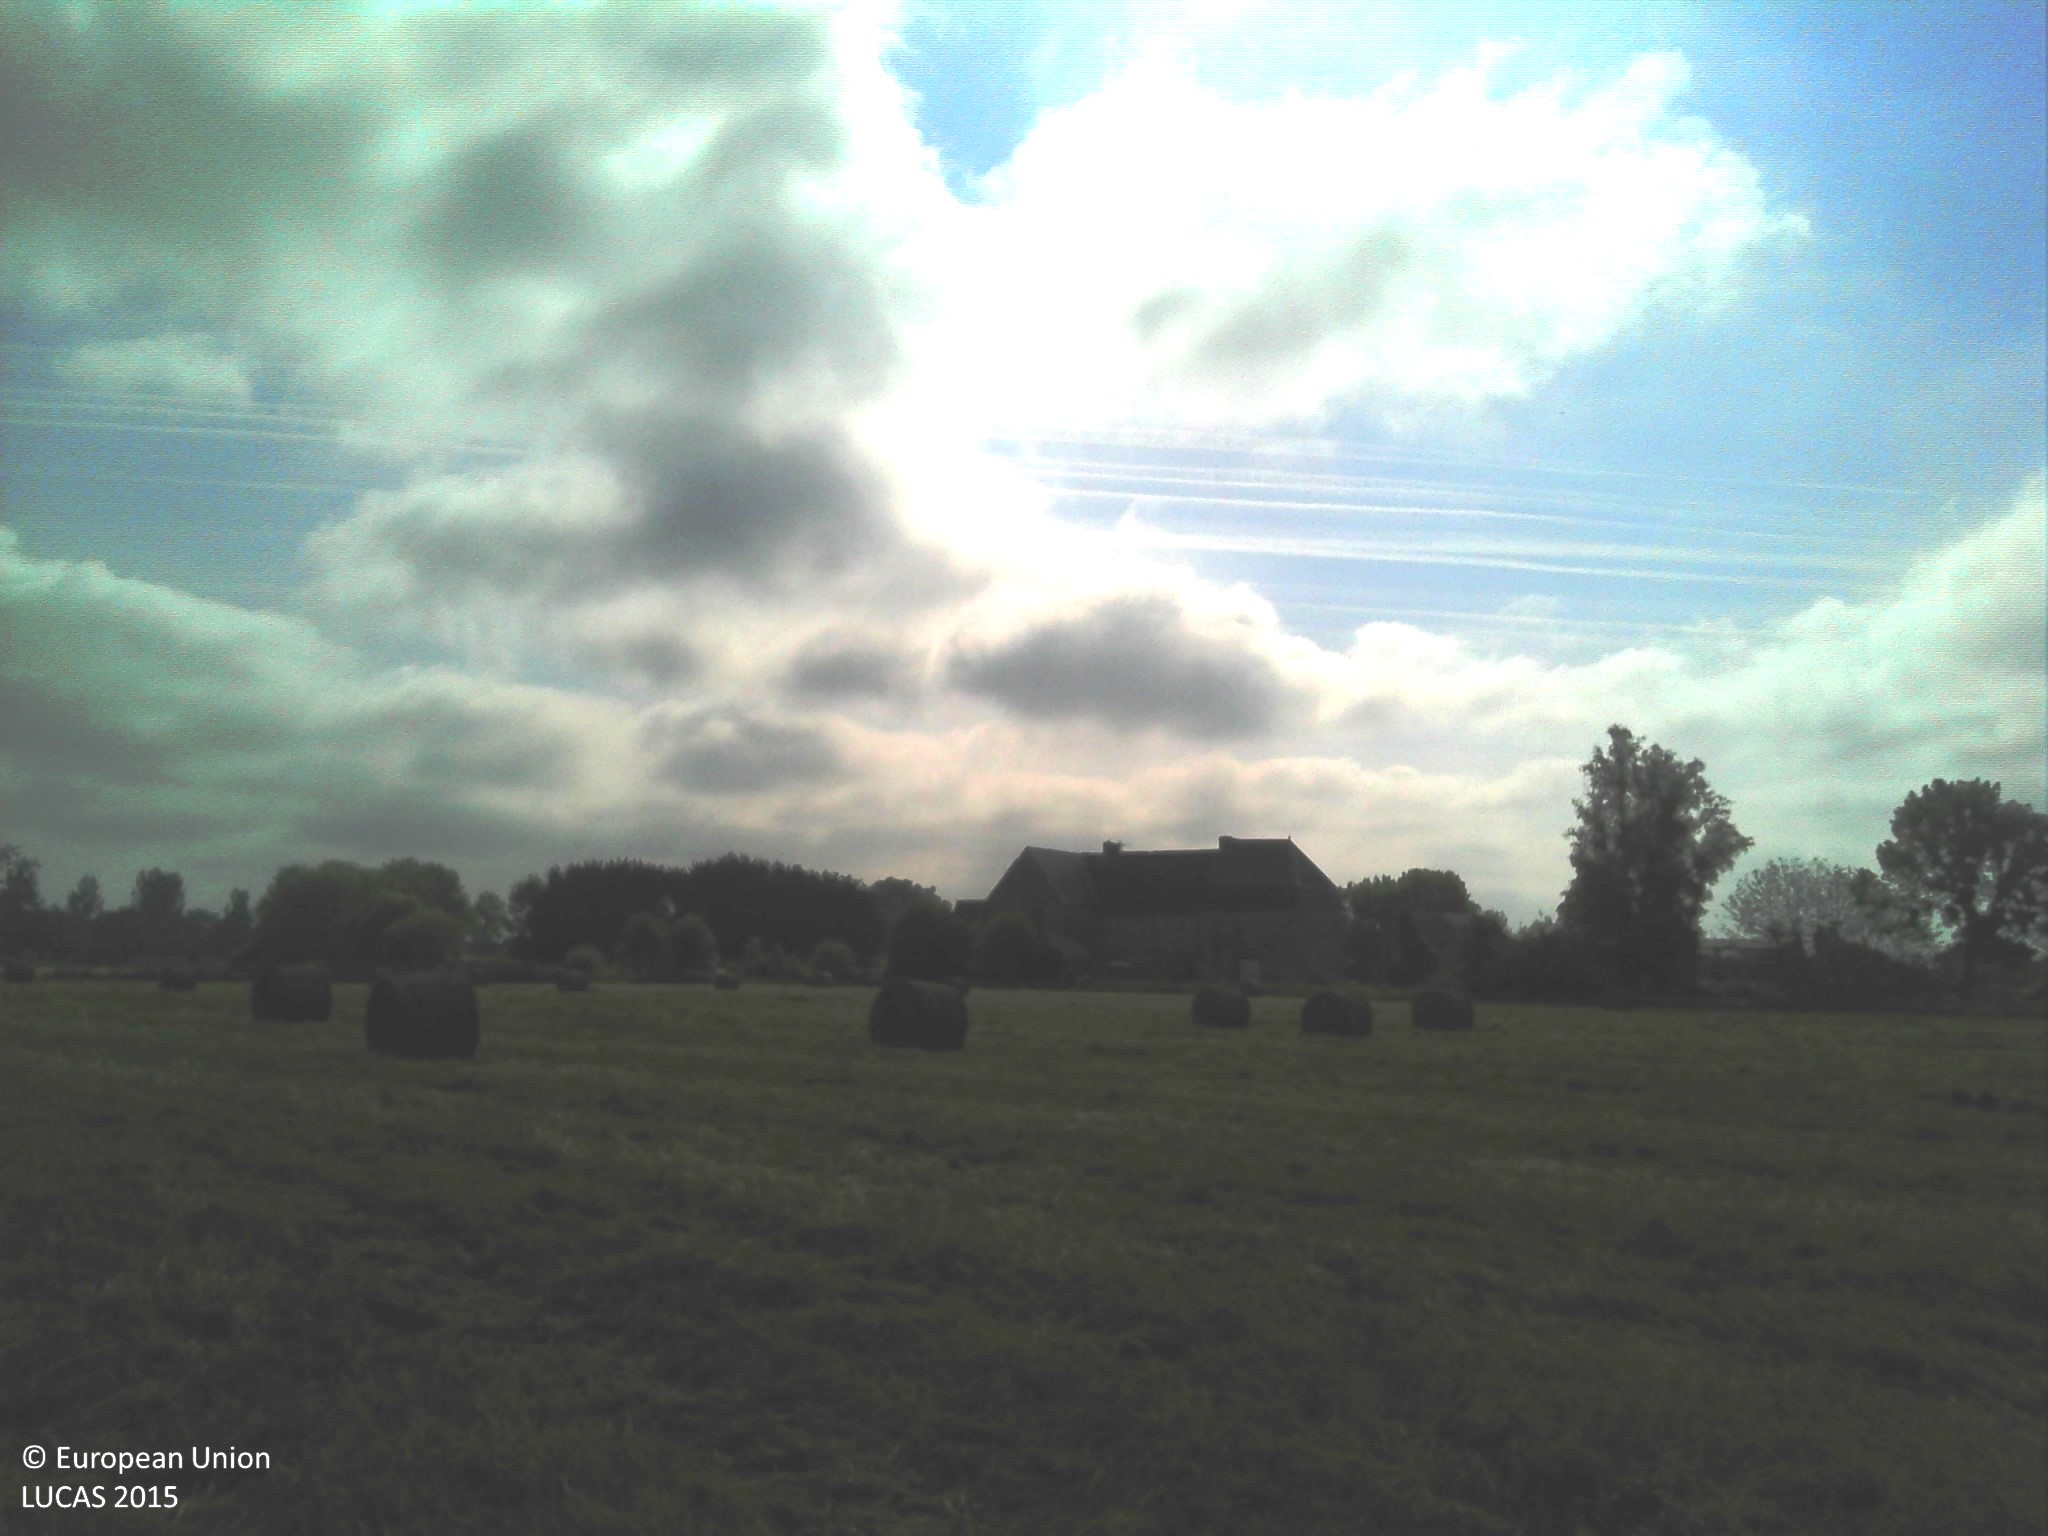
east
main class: Cropland
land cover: Maize
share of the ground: 25 - 50 %
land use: Agriculture (excluding fallow land and kitchen gardens)
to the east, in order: Managed hedges; Inland fresh running water; Grassland without tree/shrub cover; Fences; Grassland without tree/shrub cover; Fences; Grass margins; Ditches and canals; Inland fresh running water; Ditches and canals; Lines of trees; Artificial constructions in urban areas
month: June
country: FR
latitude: 48.1889
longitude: 0.2482
